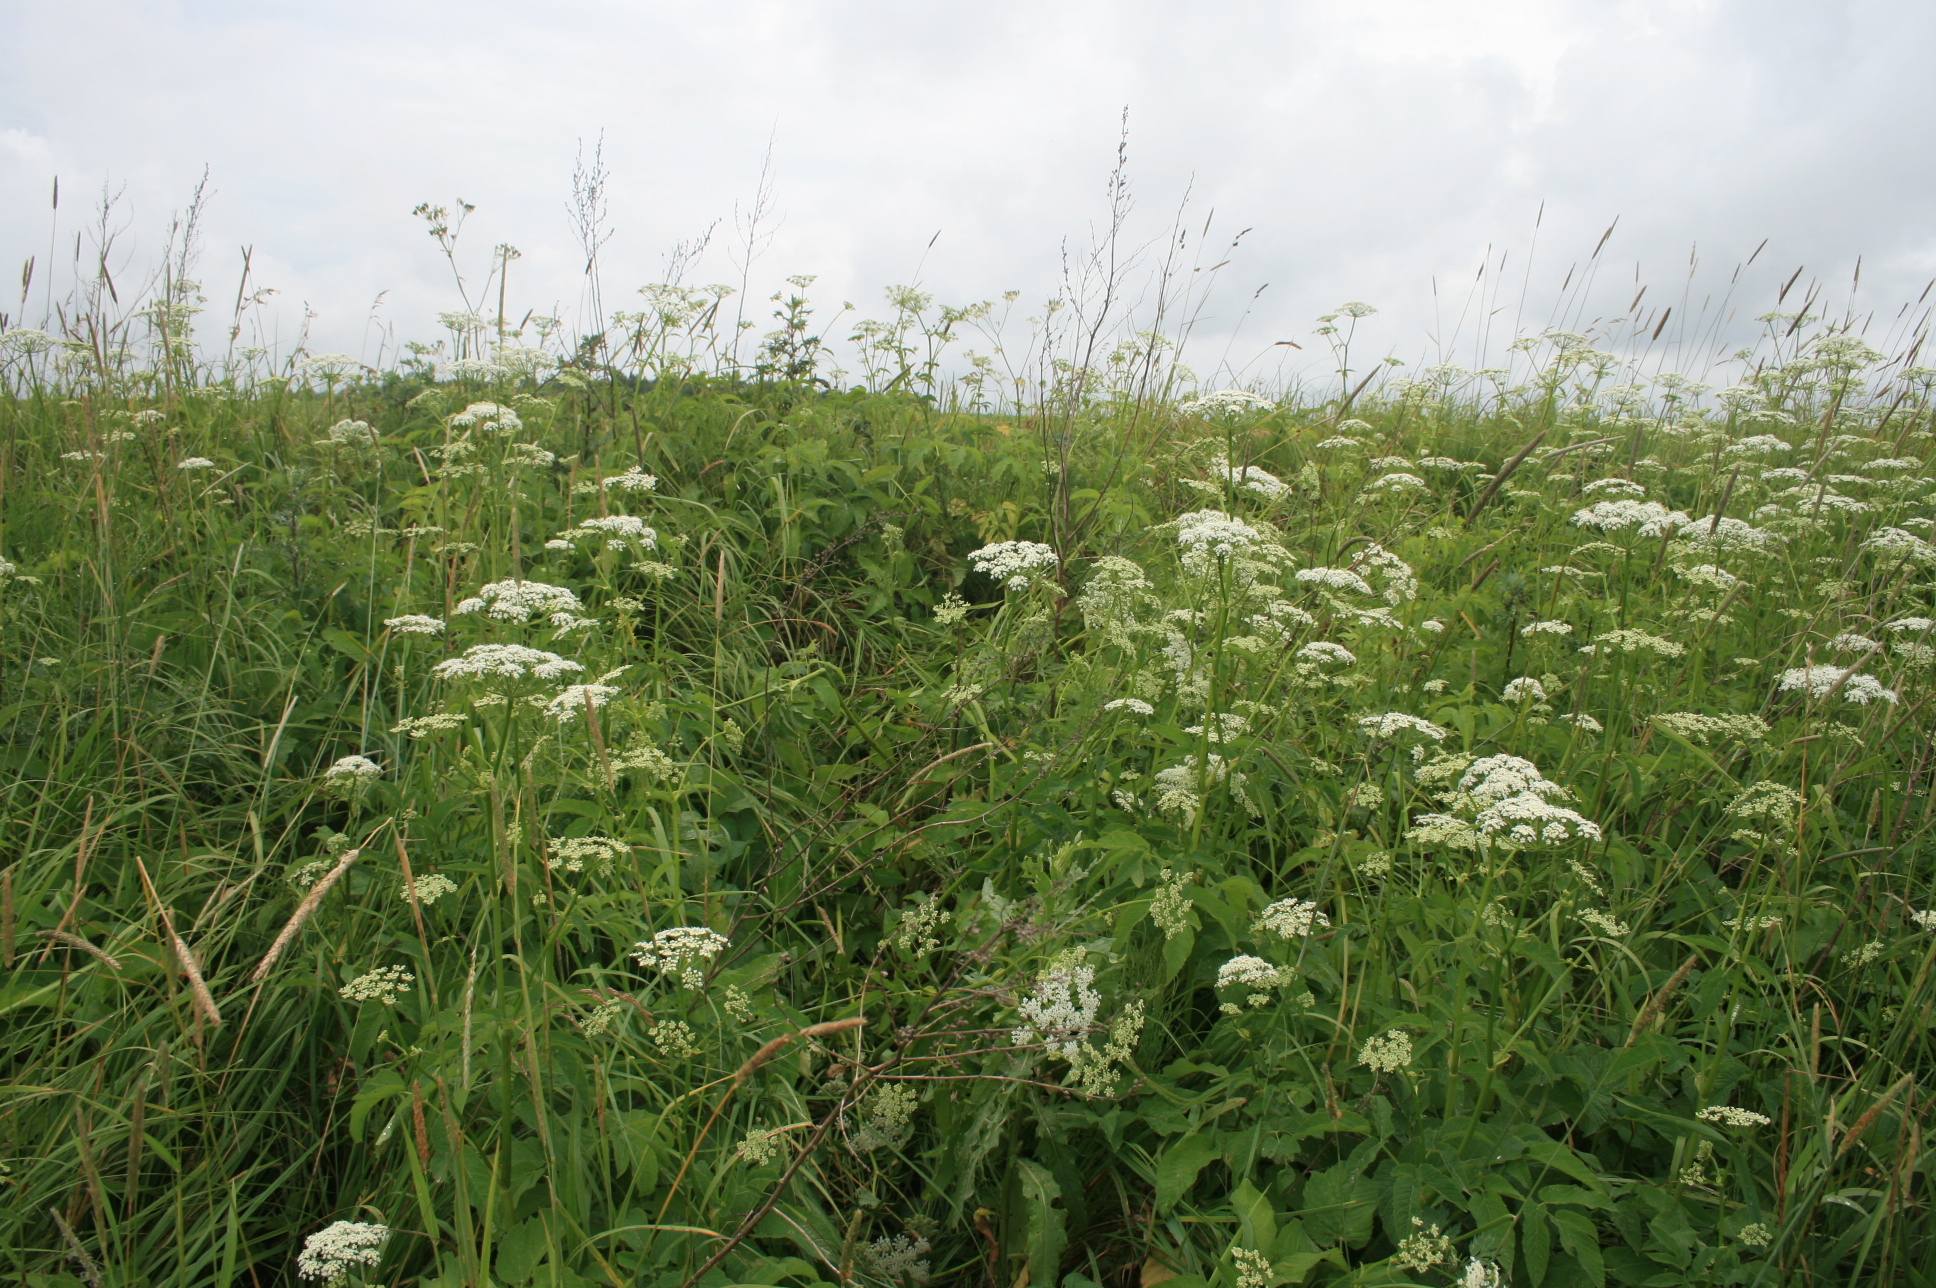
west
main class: Grassland
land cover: Grassland without tree/shrub cover
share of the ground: > 75 %
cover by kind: herbaceous plants 100 %
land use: Agriculture (excluding fallow land and kitchen gardens)
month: June
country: LT
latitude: 55.2161
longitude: 22.4306
